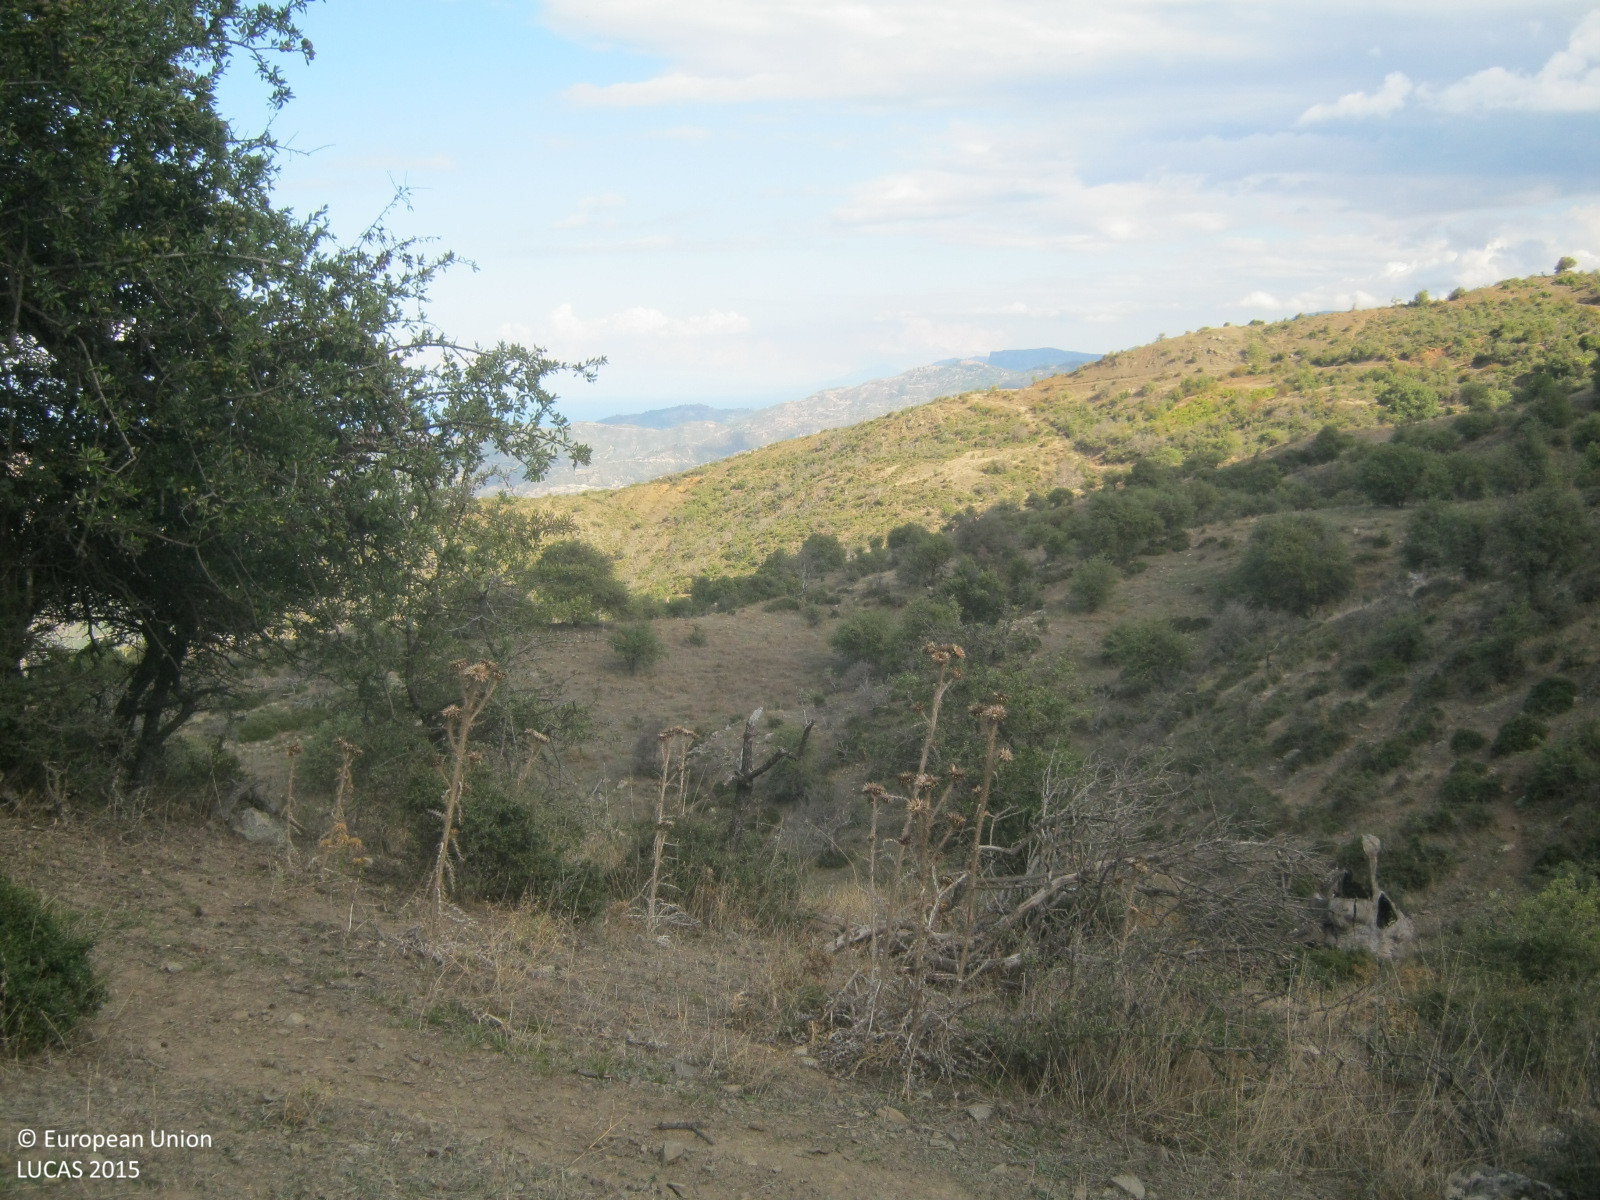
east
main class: Shrubland
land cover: Shrubland with sparse tree cover
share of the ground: 25 - 50 %
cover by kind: herbaceous plants 50 %, shrubs 25 %, unconsolidated bare surface 20 %, broadleaved forest trees 5 %
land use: Agriculture (excluding fallow land and kitchen gardens)
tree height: < 5 m
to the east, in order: Shrubland with sparse tree cover; Grassland with sparse tree/shrub cover; Shrubland with sparse tree cover; Pear fruit
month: September
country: GR
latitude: 38.1383
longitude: 22.1426
